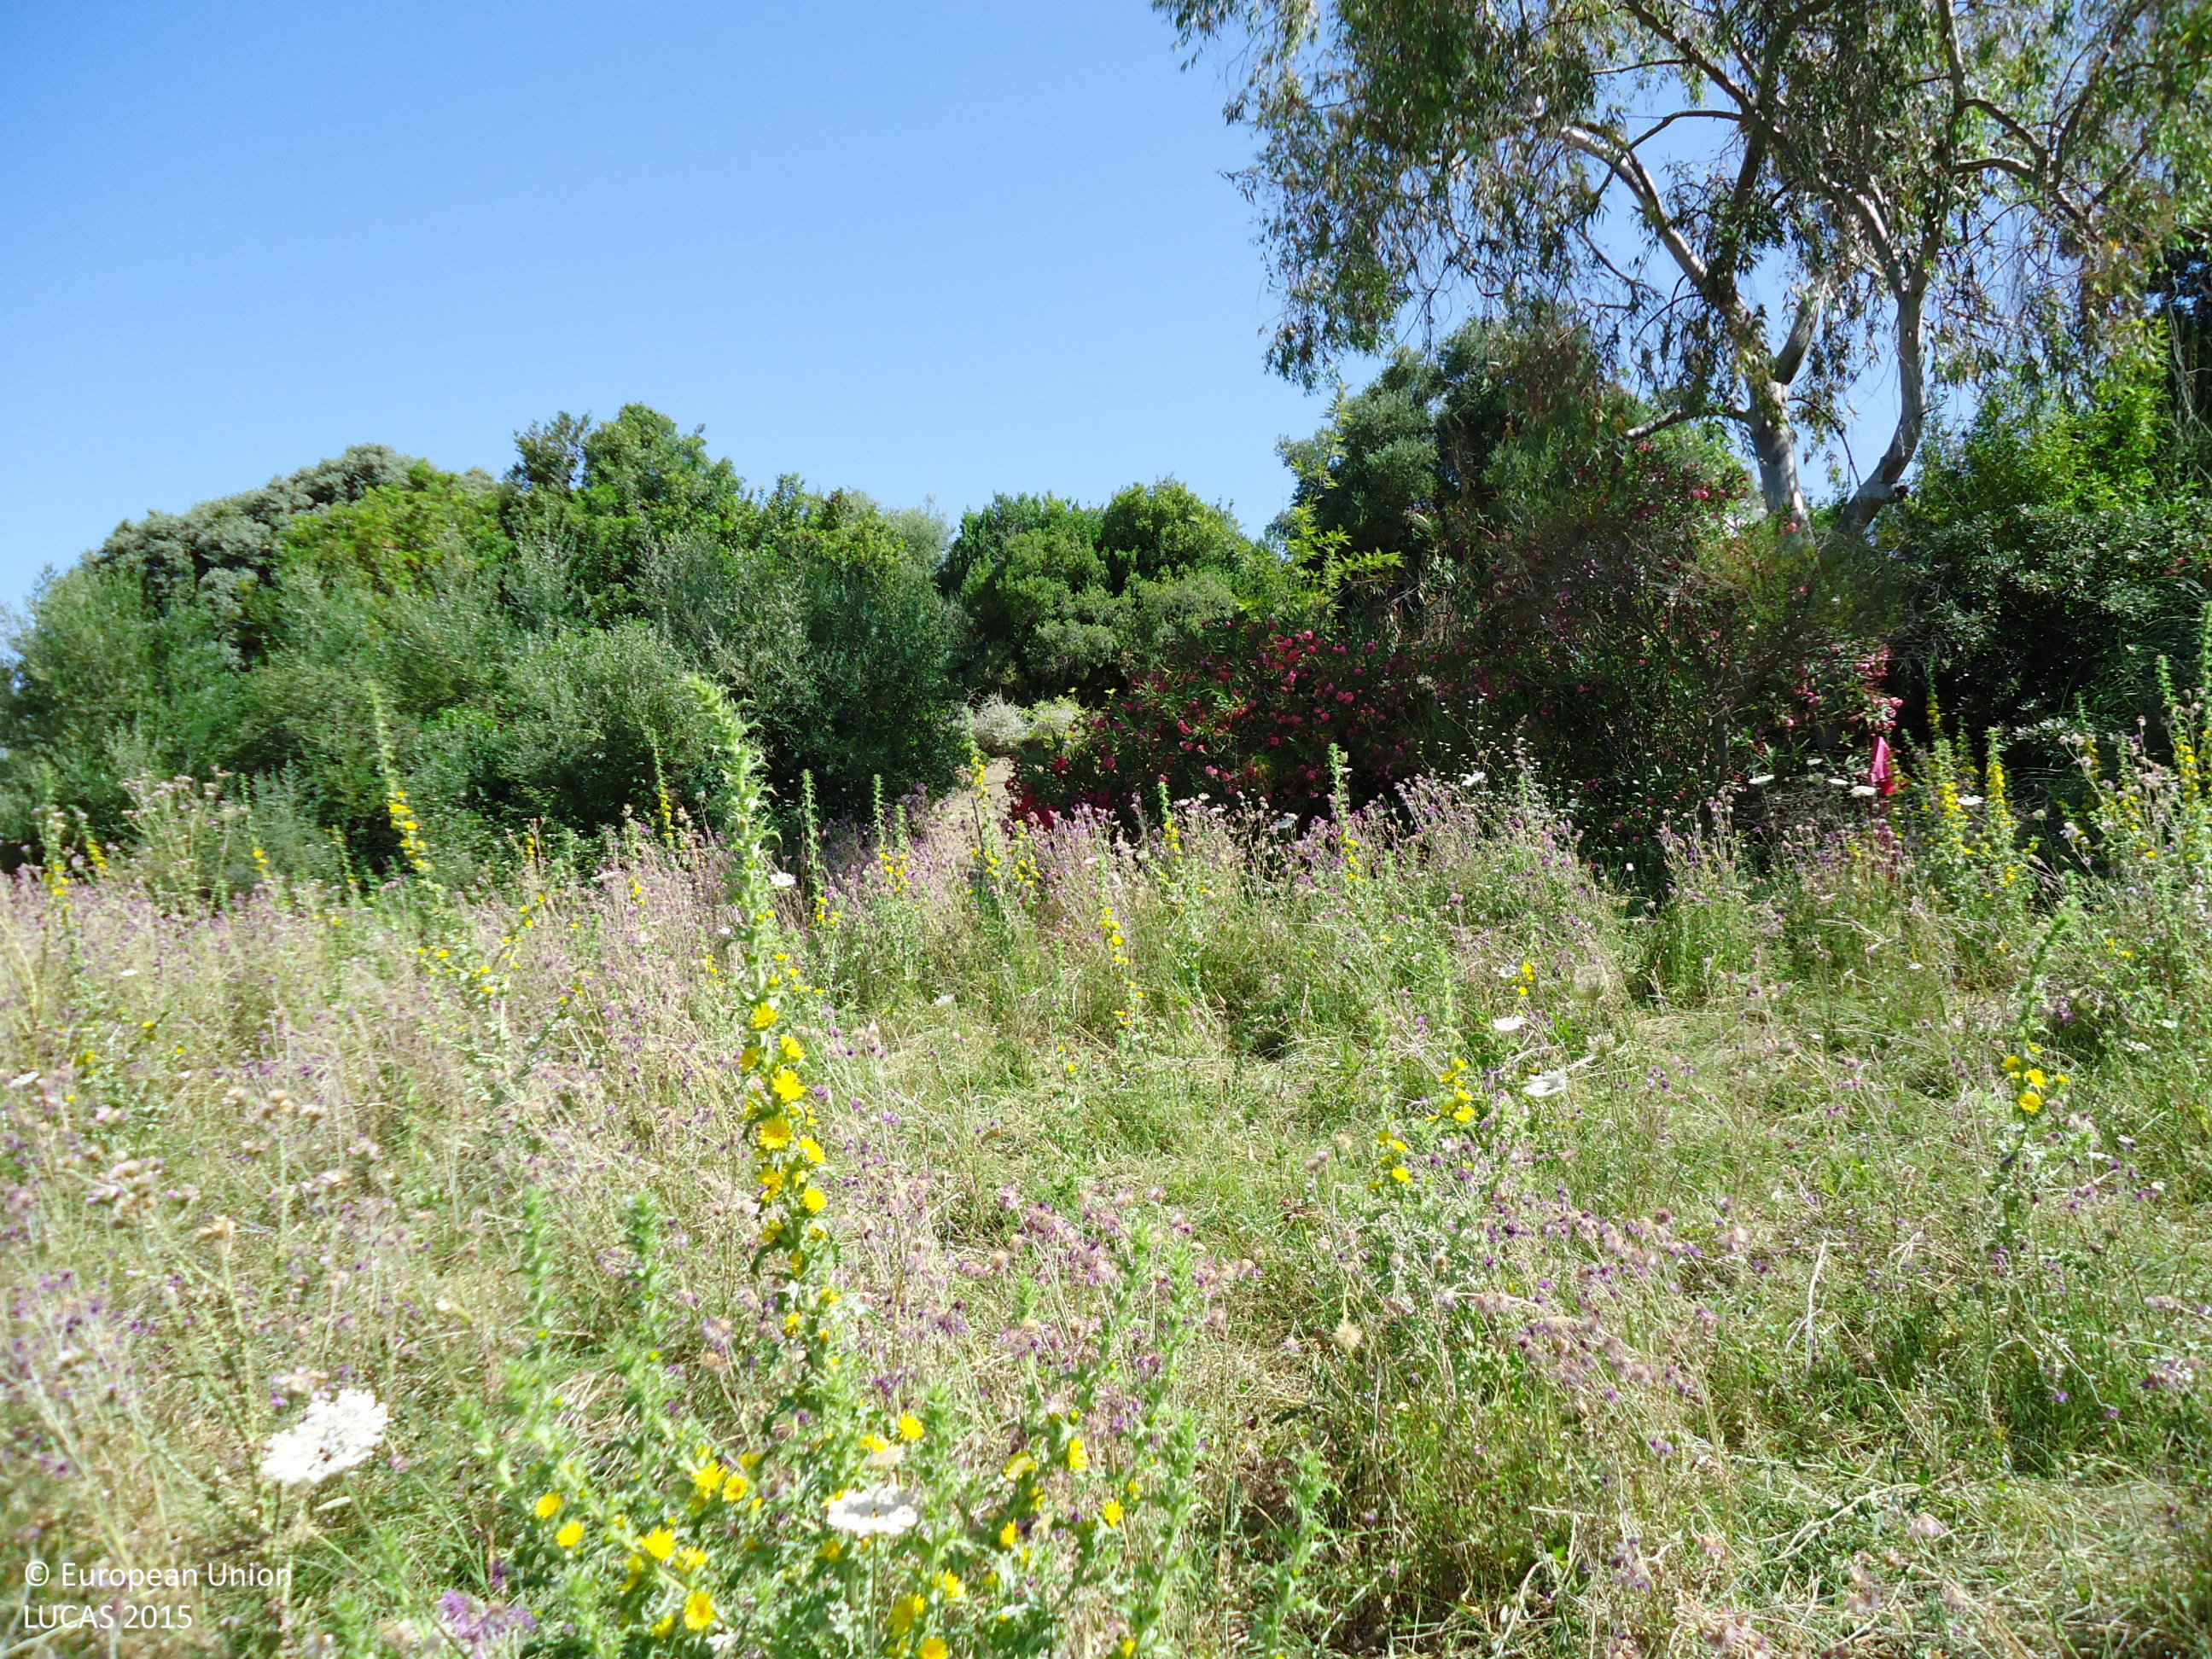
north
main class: Grassland
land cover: Grassland with sparse tree/shrub cover
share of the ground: > 75 %
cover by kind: herbaceous plants 95 %, broadleaved forest trees 5 %
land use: Agriculture (excluding fallow land and kitchen gardens)
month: June
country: ES
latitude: 36.4902
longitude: -5.3685
